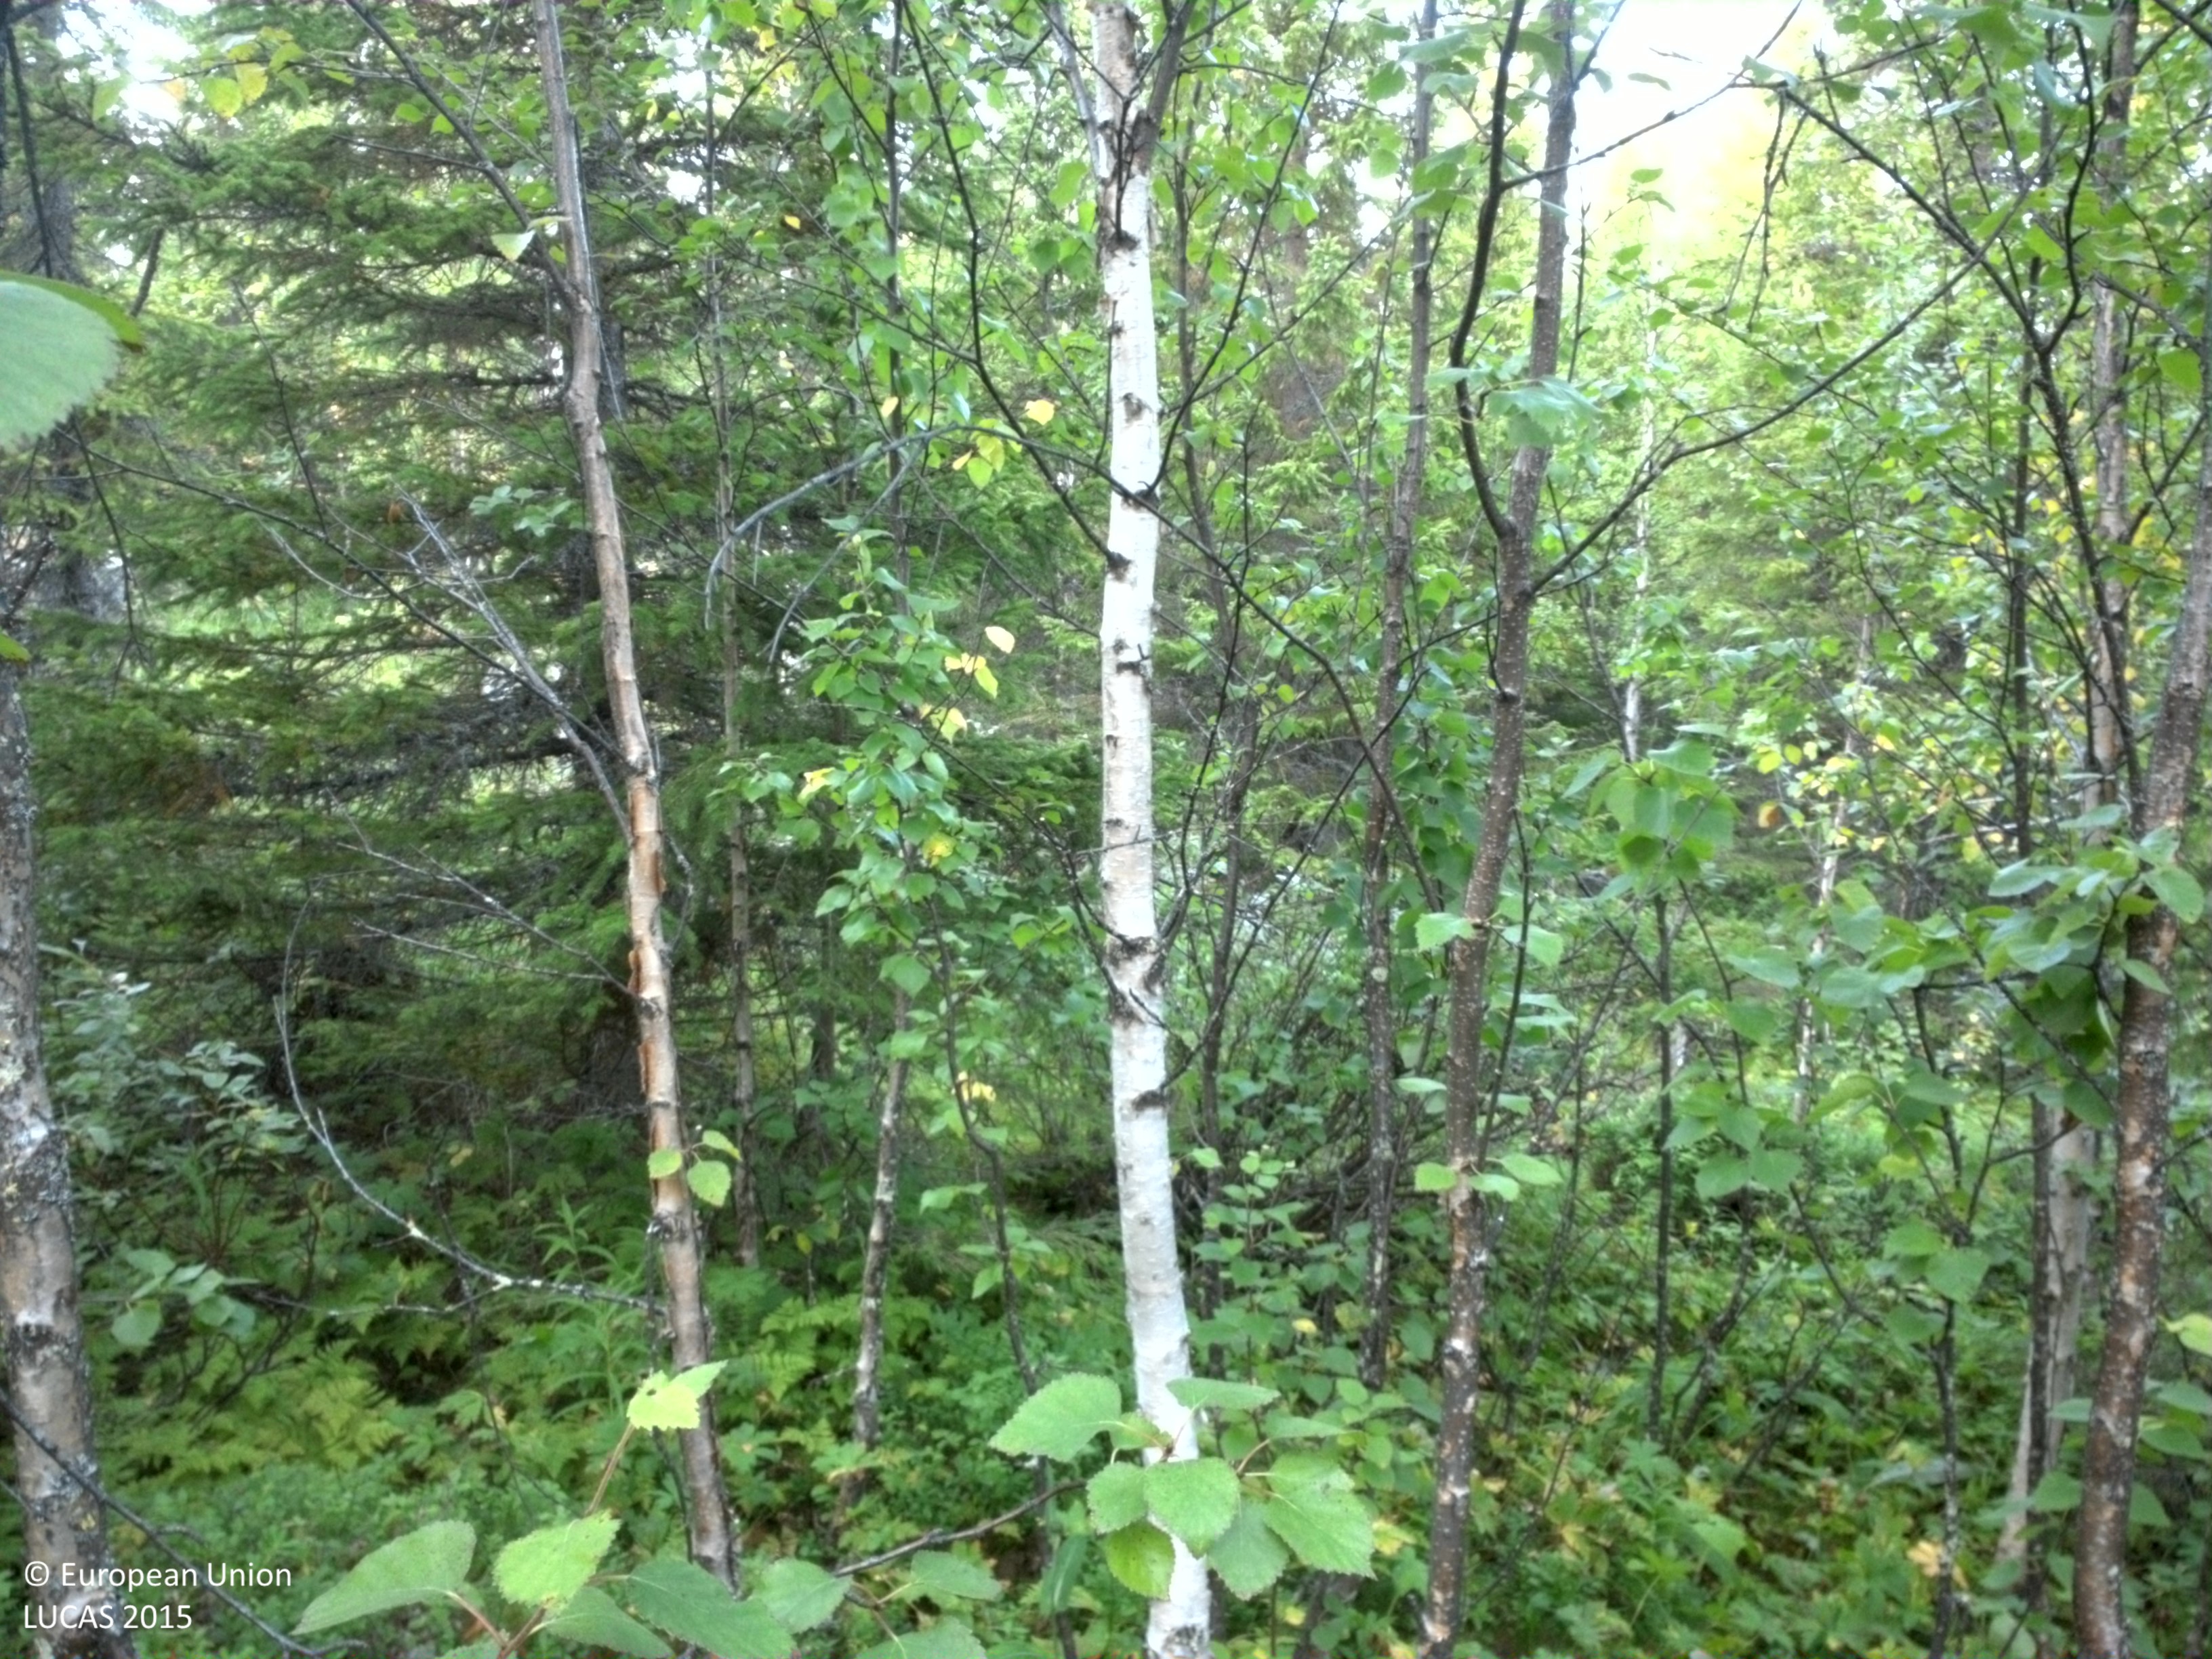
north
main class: Woodland
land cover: Spruce dominated mixed woodland
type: boreal forest
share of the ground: 50 - 75 %
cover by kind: broadleaved forest trees 40 %, coniferous forest trees 30 %, shrubs 15 %, herbaceous plants 15 %
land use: Forestry
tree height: > 5 m
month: September
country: SE
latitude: 65.1825
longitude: 16.2204
